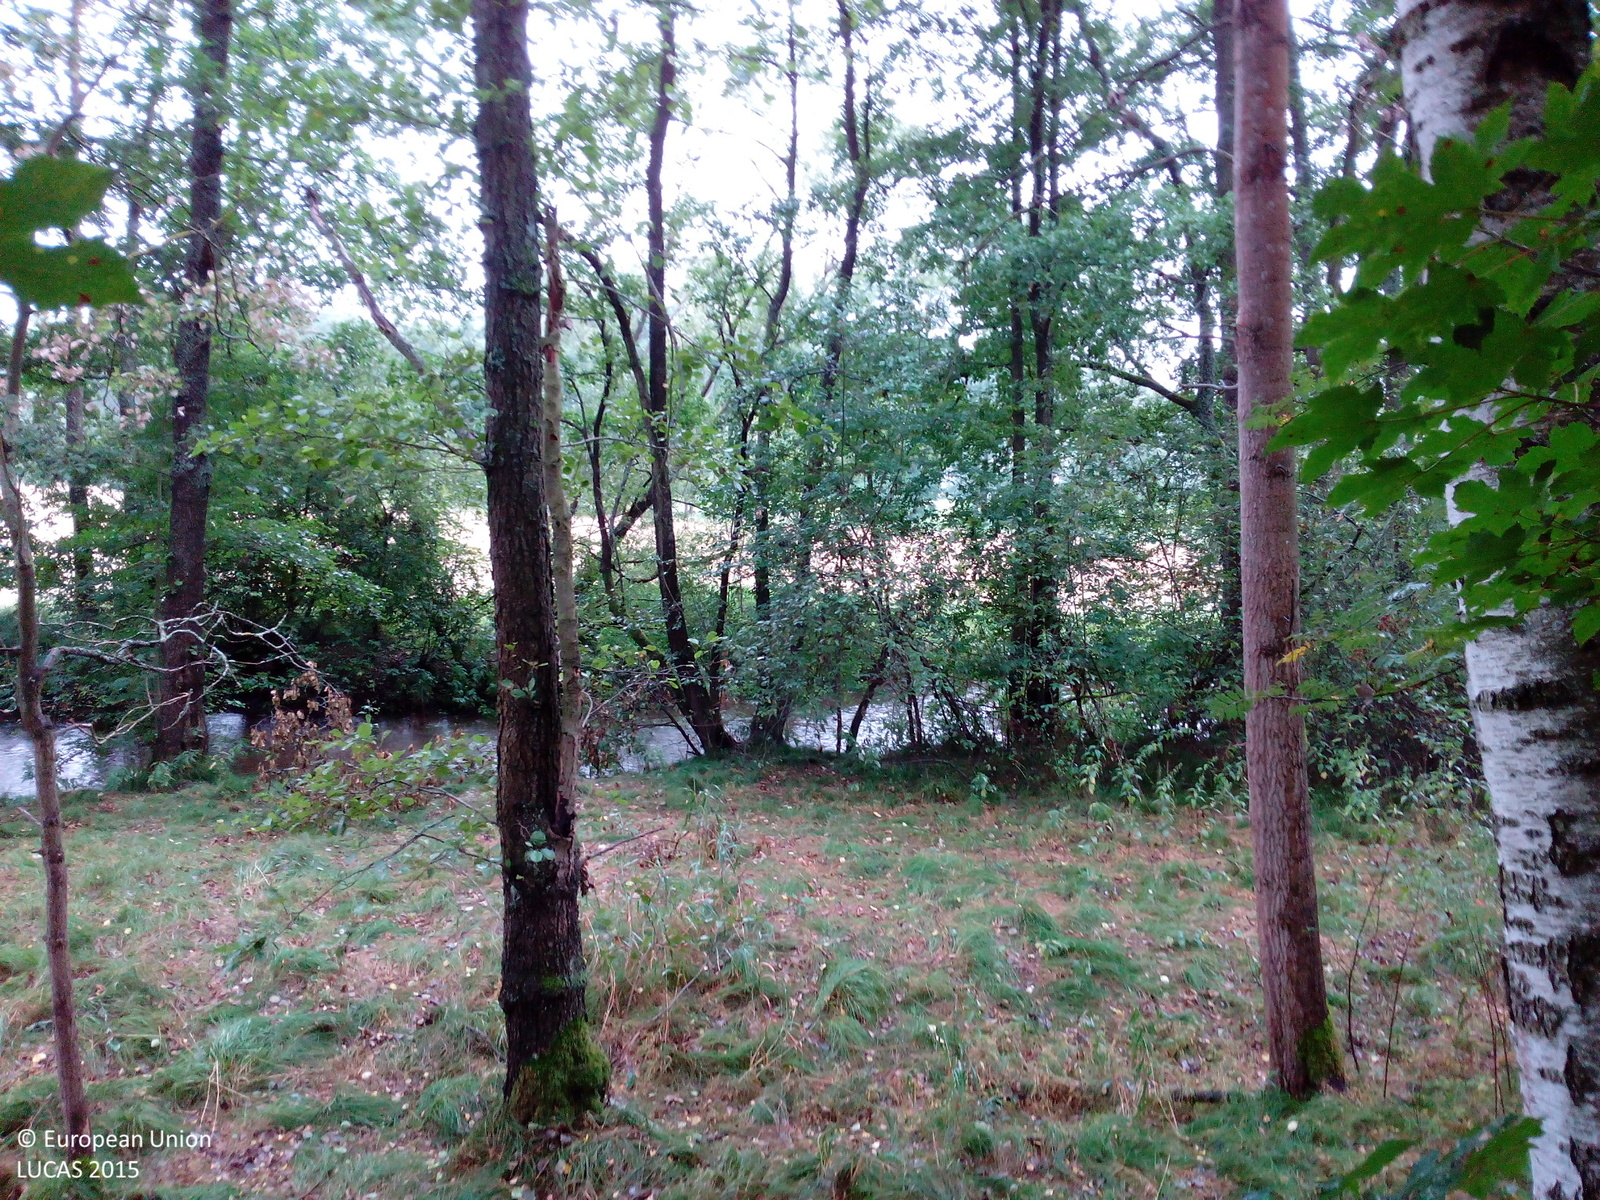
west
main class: Woodland
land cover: Broadleaved woodland
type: floodplain forest
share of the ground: > 75 %
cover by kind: broadleaved forest trees 90 %, herbaceous plants 10 %
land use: Semi-natural and natural areas not in use
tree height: > 5 m
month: August
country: DE
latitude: 50.1292
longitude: 12.0839
